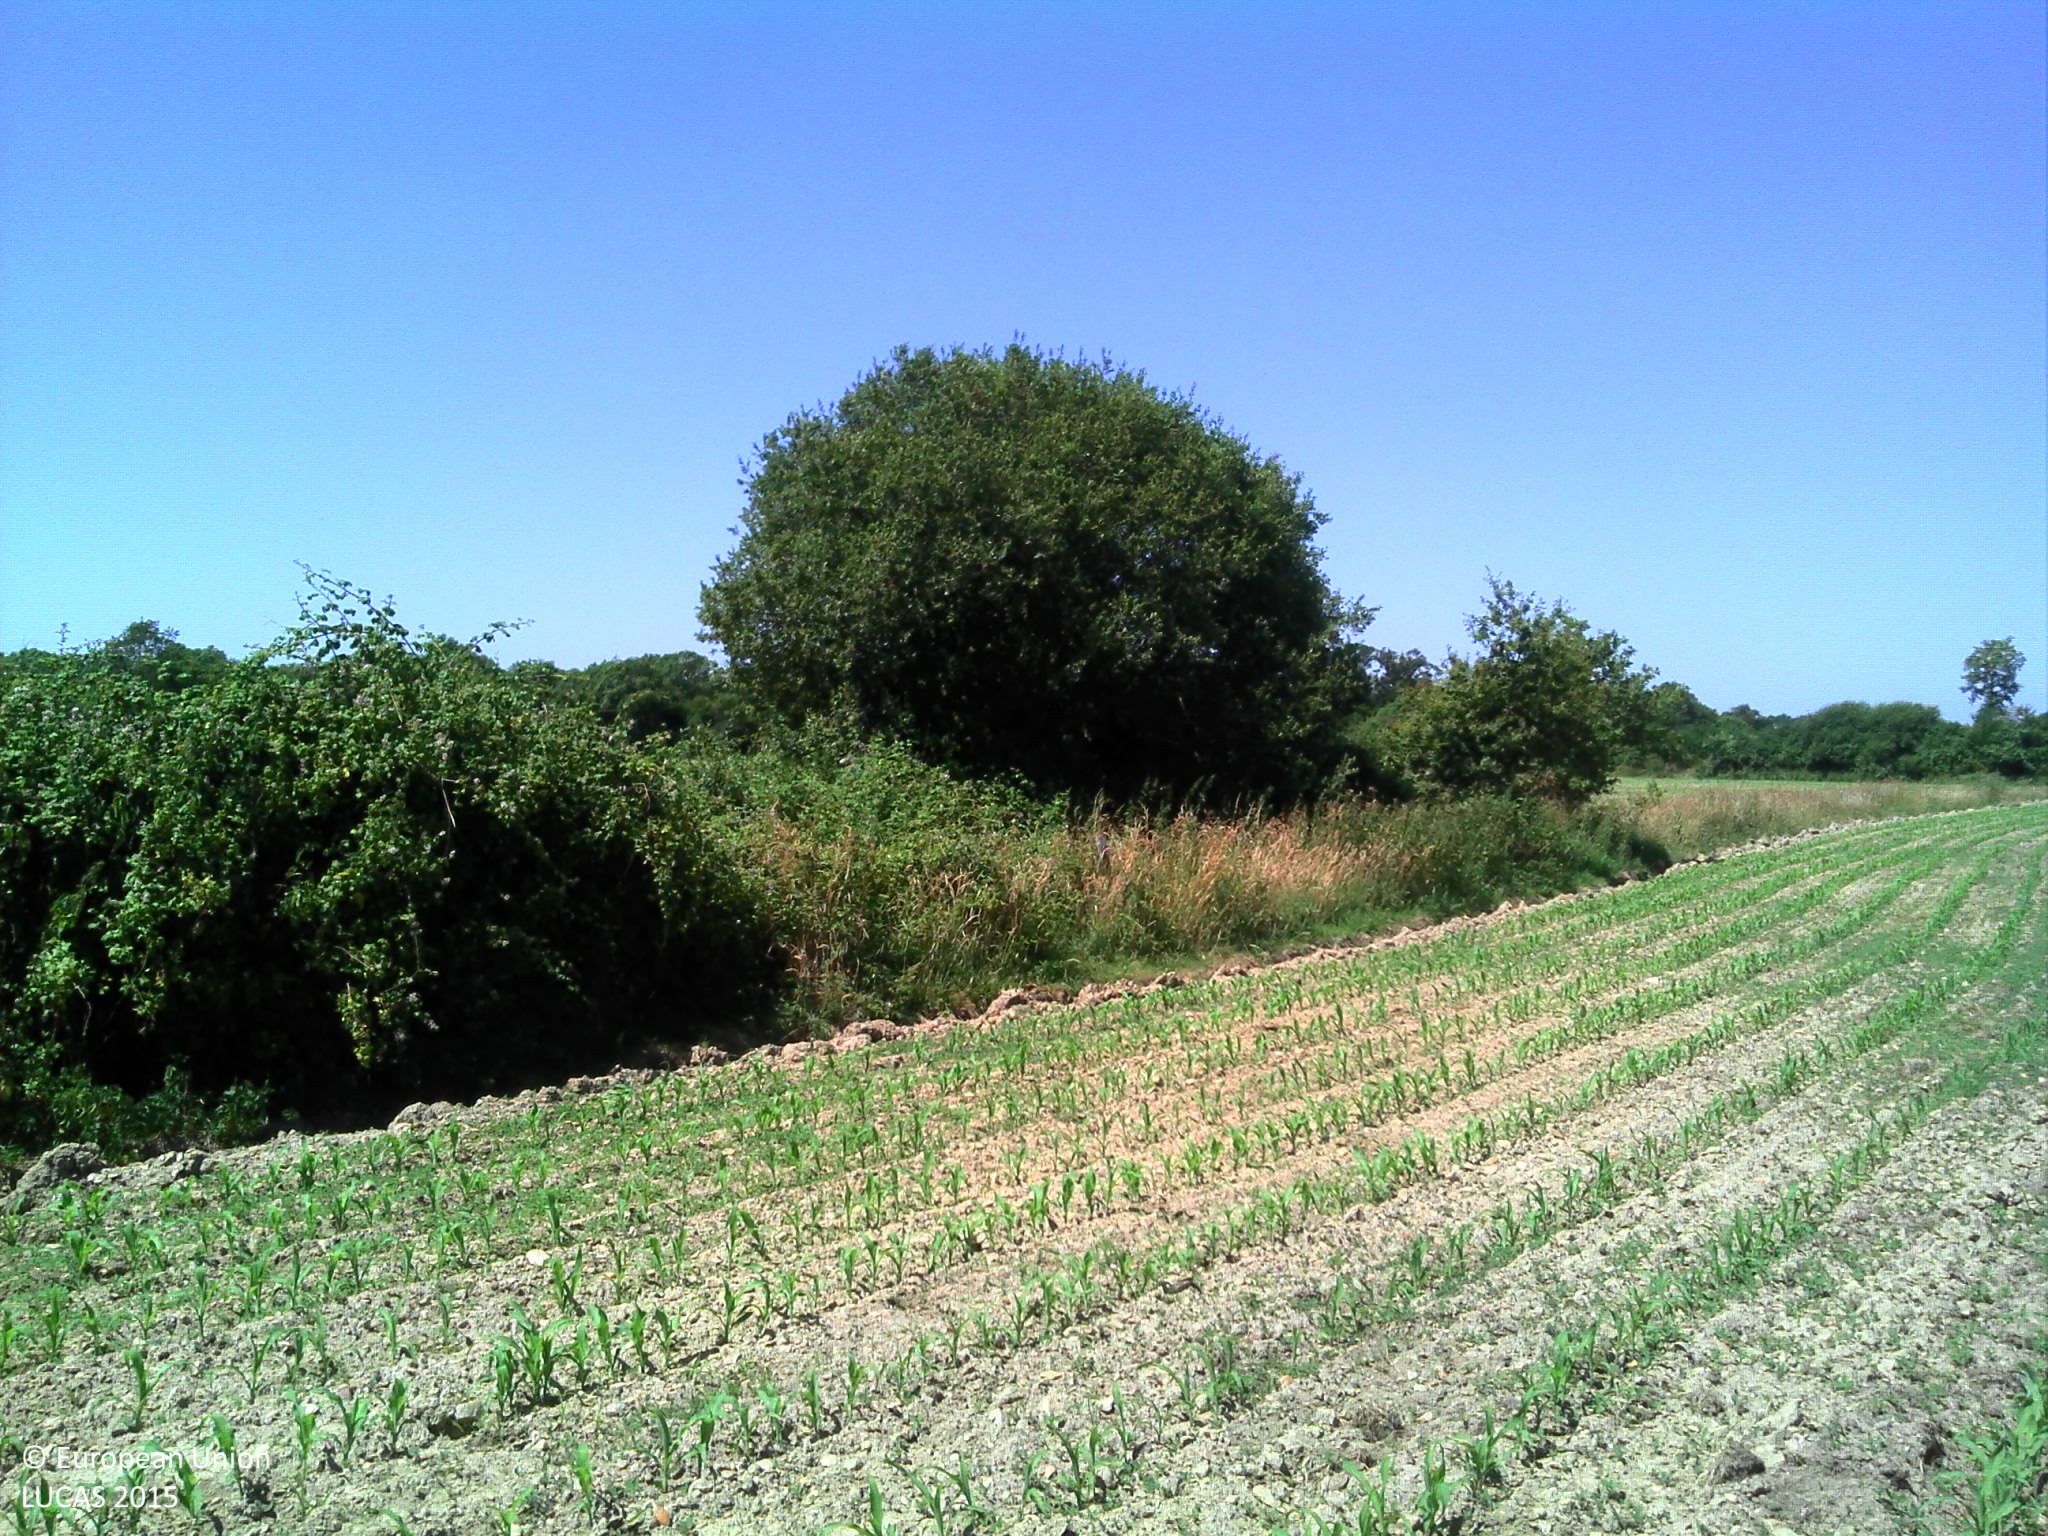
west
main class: Cropland
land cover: Maize
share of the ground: 10 - 25 %
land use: Agriculture (excluding fallow land and kitchen gardens)
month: June
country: FR
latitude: 46.9504
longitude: -1.8035
